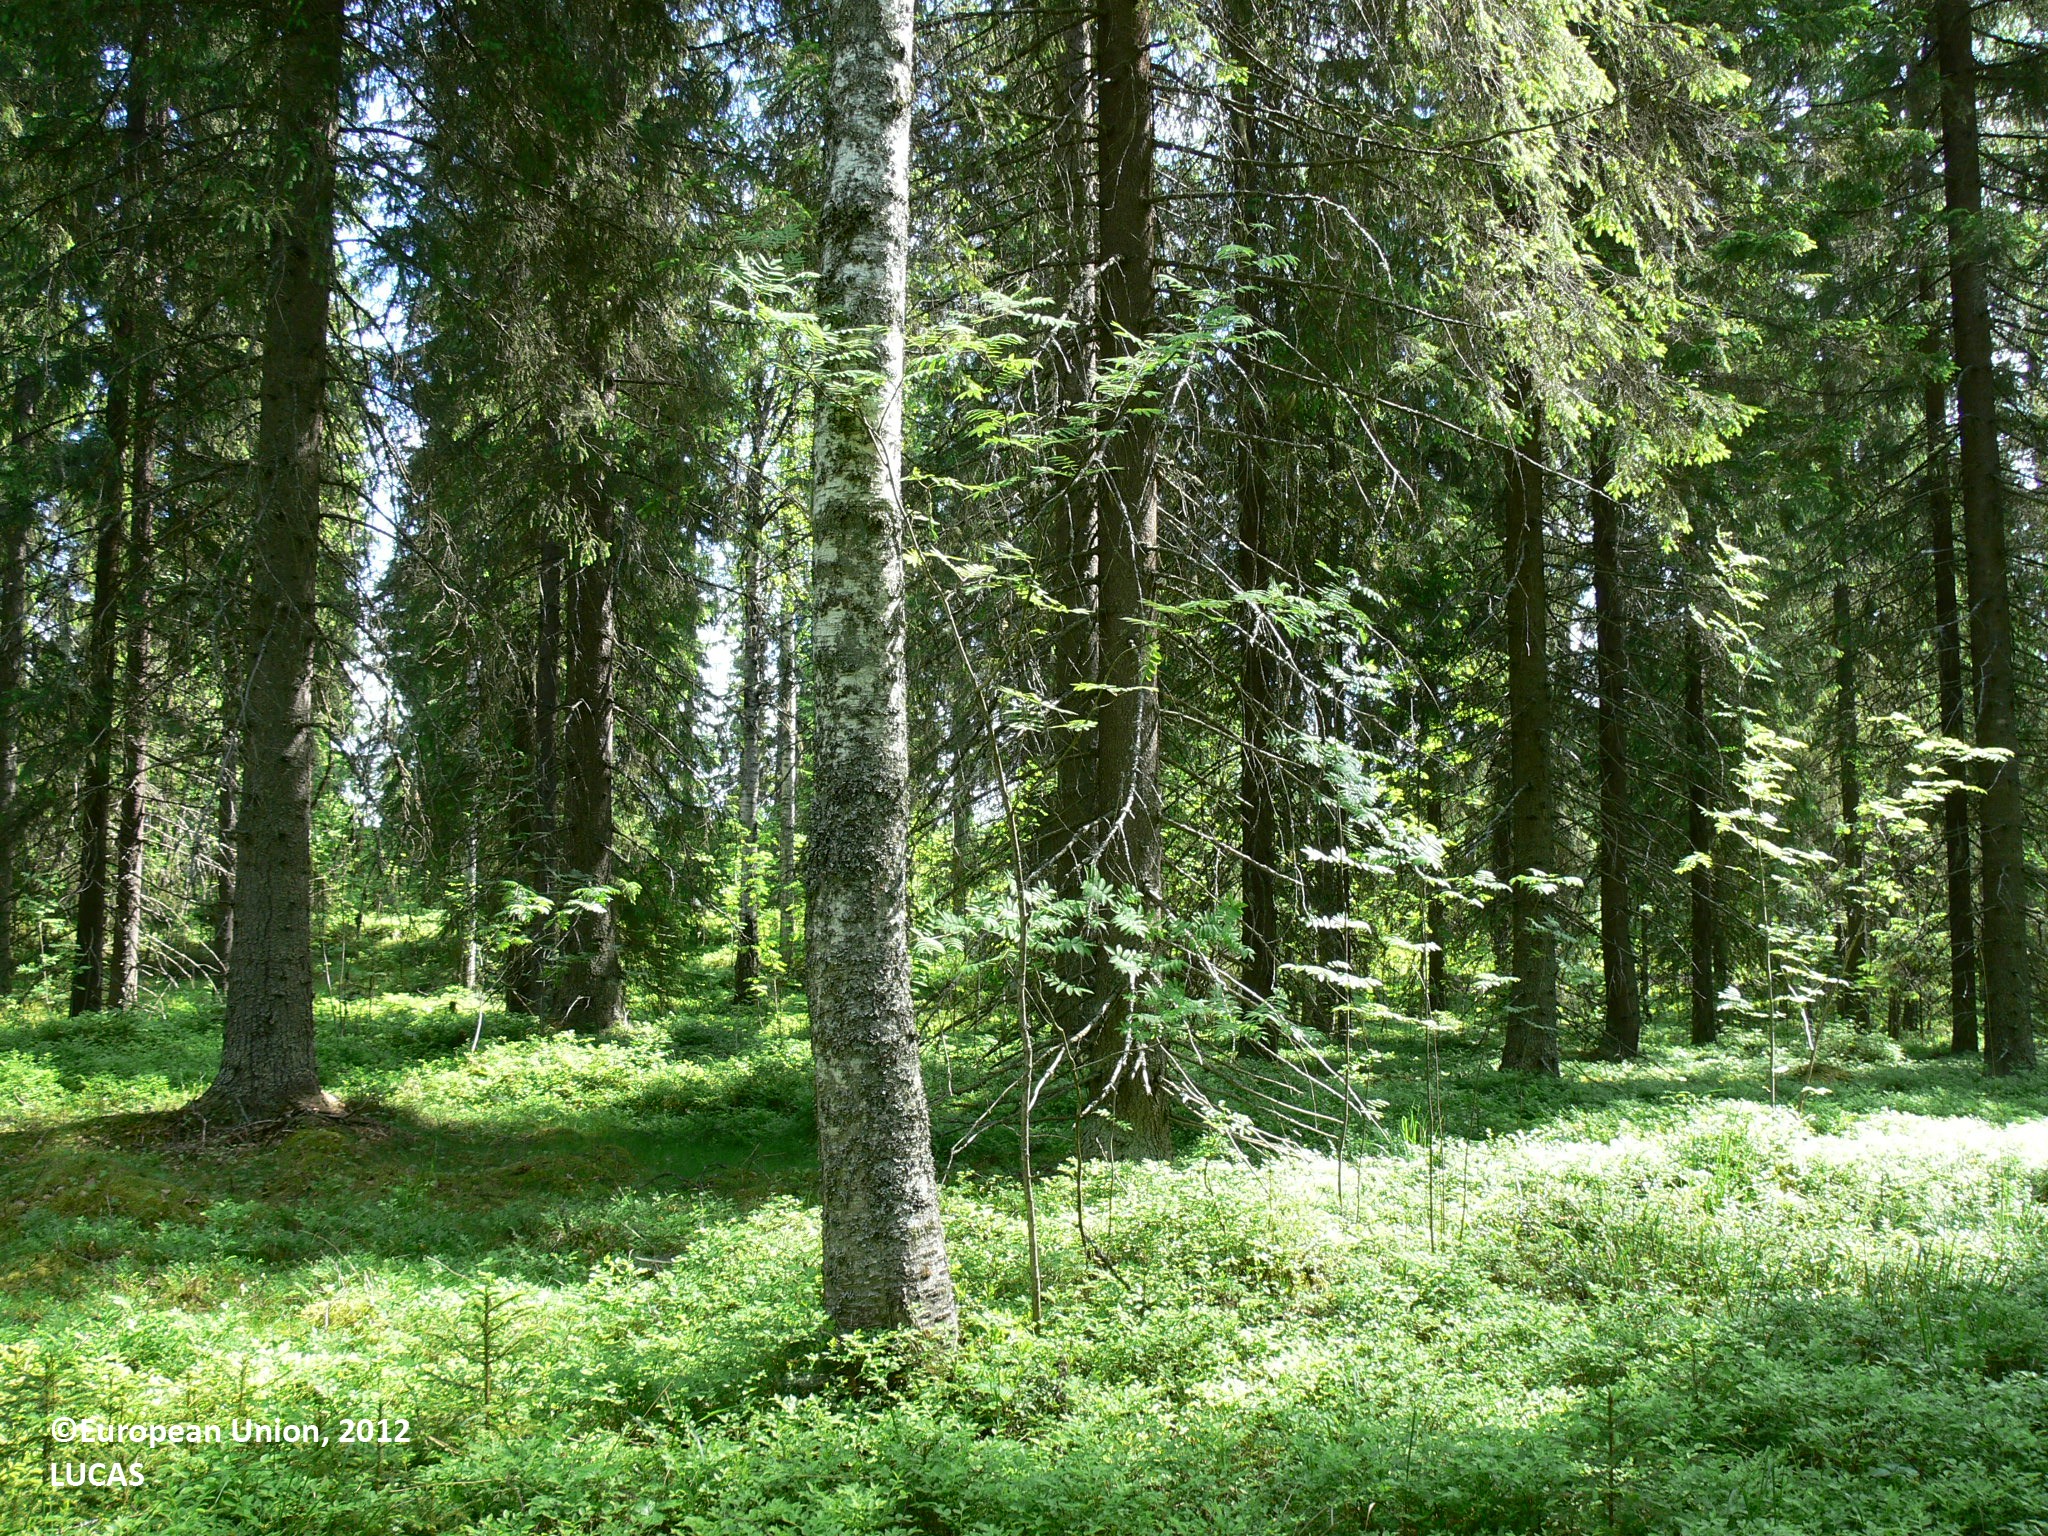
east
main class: Woodland
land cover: Spruce dominated mixed woodland
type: boreal forest
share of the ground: > 75 %
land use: Forestry
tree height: > 5 m
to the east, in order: Spruce dominated mixed woodland; Spruce dominated coniferous woodland; Grass margins; Paved roads, cycling and walking lanes; Grass margins; Spruce dominated mixed woodland; Spruce dominated coniferous woodland; Ditches and canals; Spruce dominated mixed woodland; Spruce dominated coniferous woodland
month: June
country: FI
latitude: 62.8158
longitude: 29.8919
